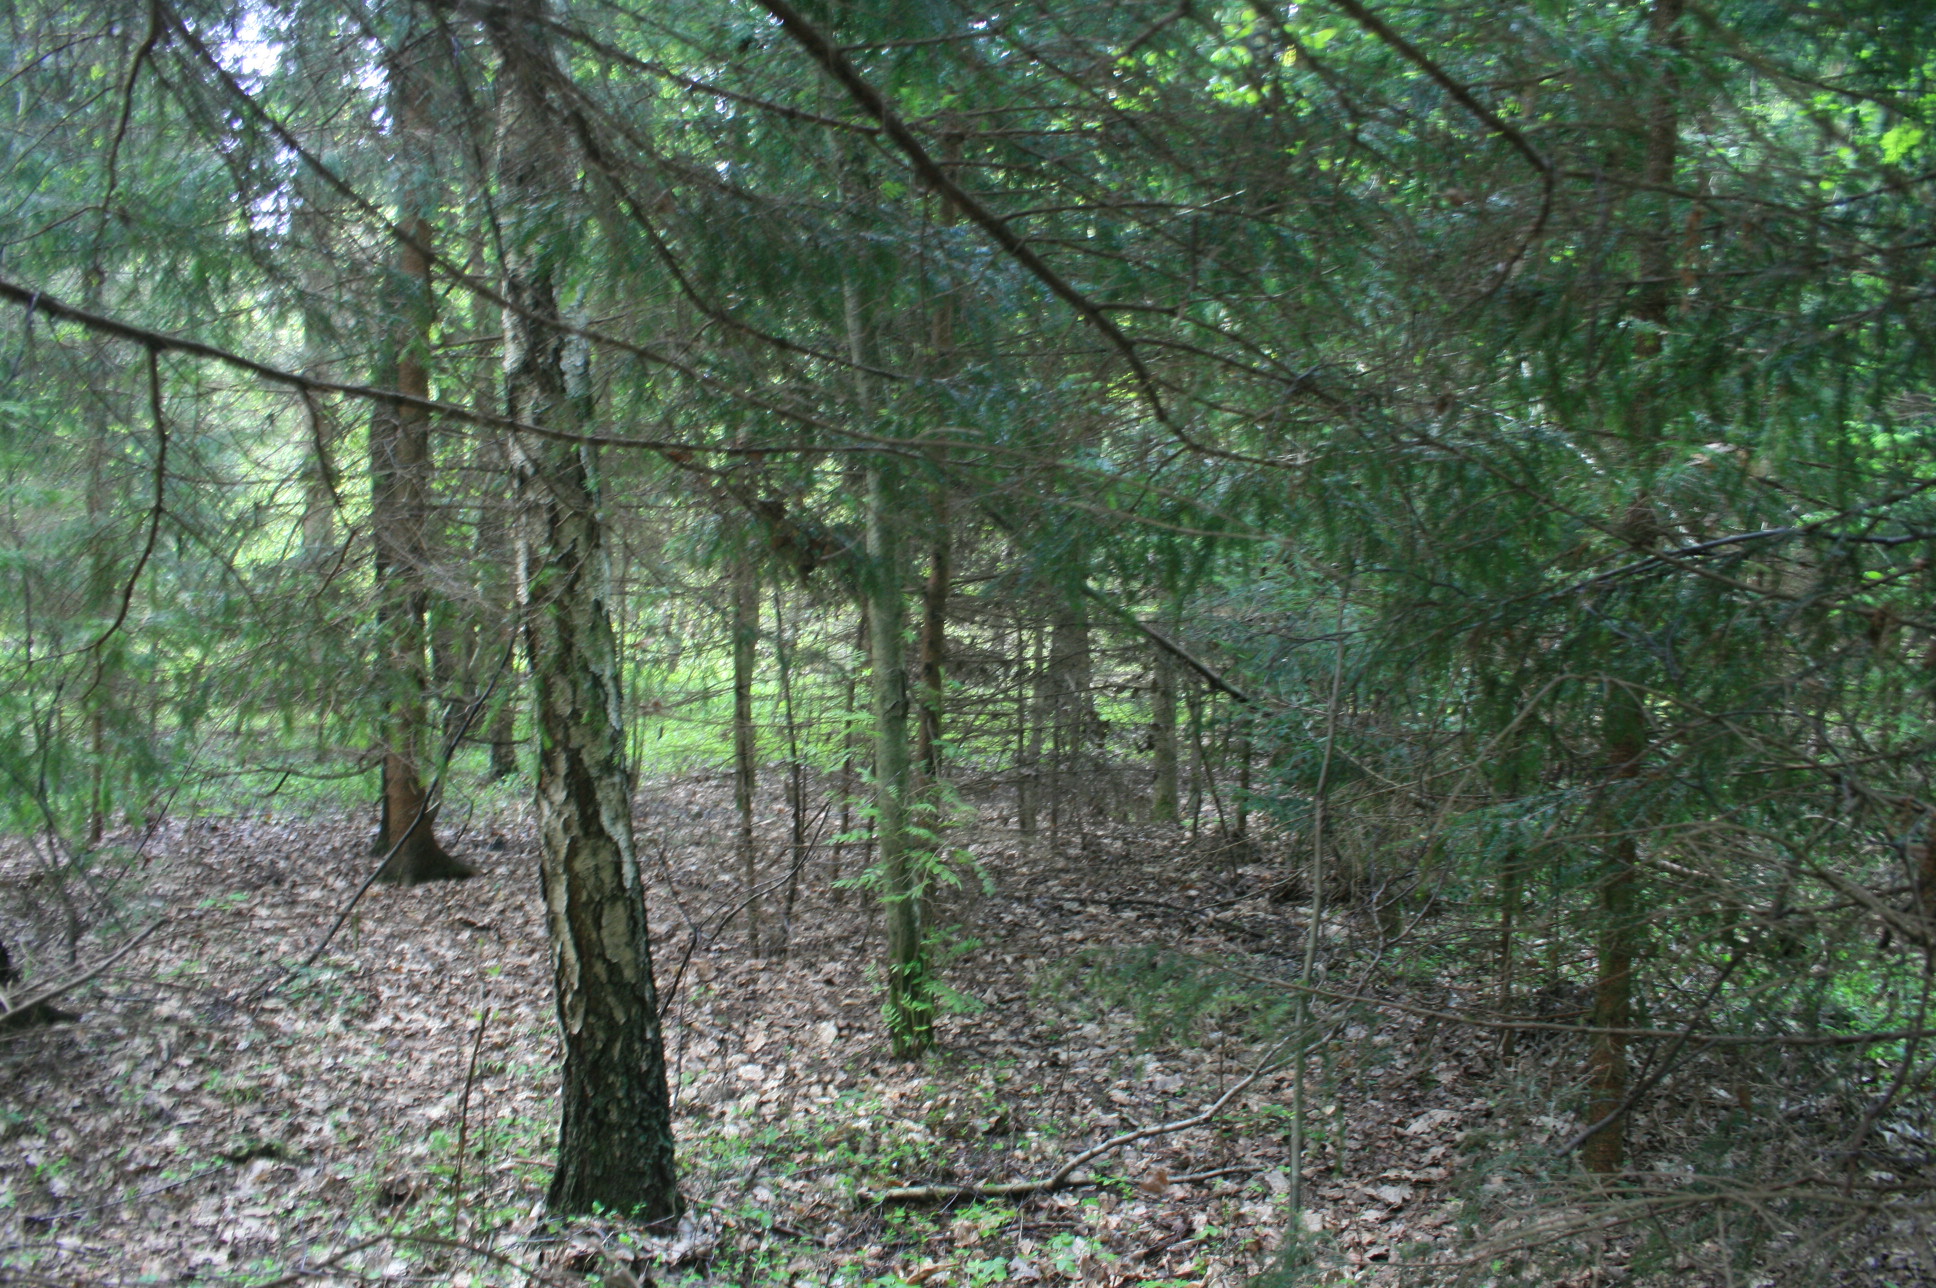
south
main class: Woodland
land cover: Spruce dominated mixed woodland
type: hemiboreal forest and nemoral coniferous forest and mixed broadleaved-coniferous forest
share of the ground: > 75 %
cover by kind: coniferous forest trees 70 %, broadleaved forest trees 30 %
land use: Forestry
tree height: > 5 m
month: May
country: LT
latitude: 55.7629
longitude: 21.8595
